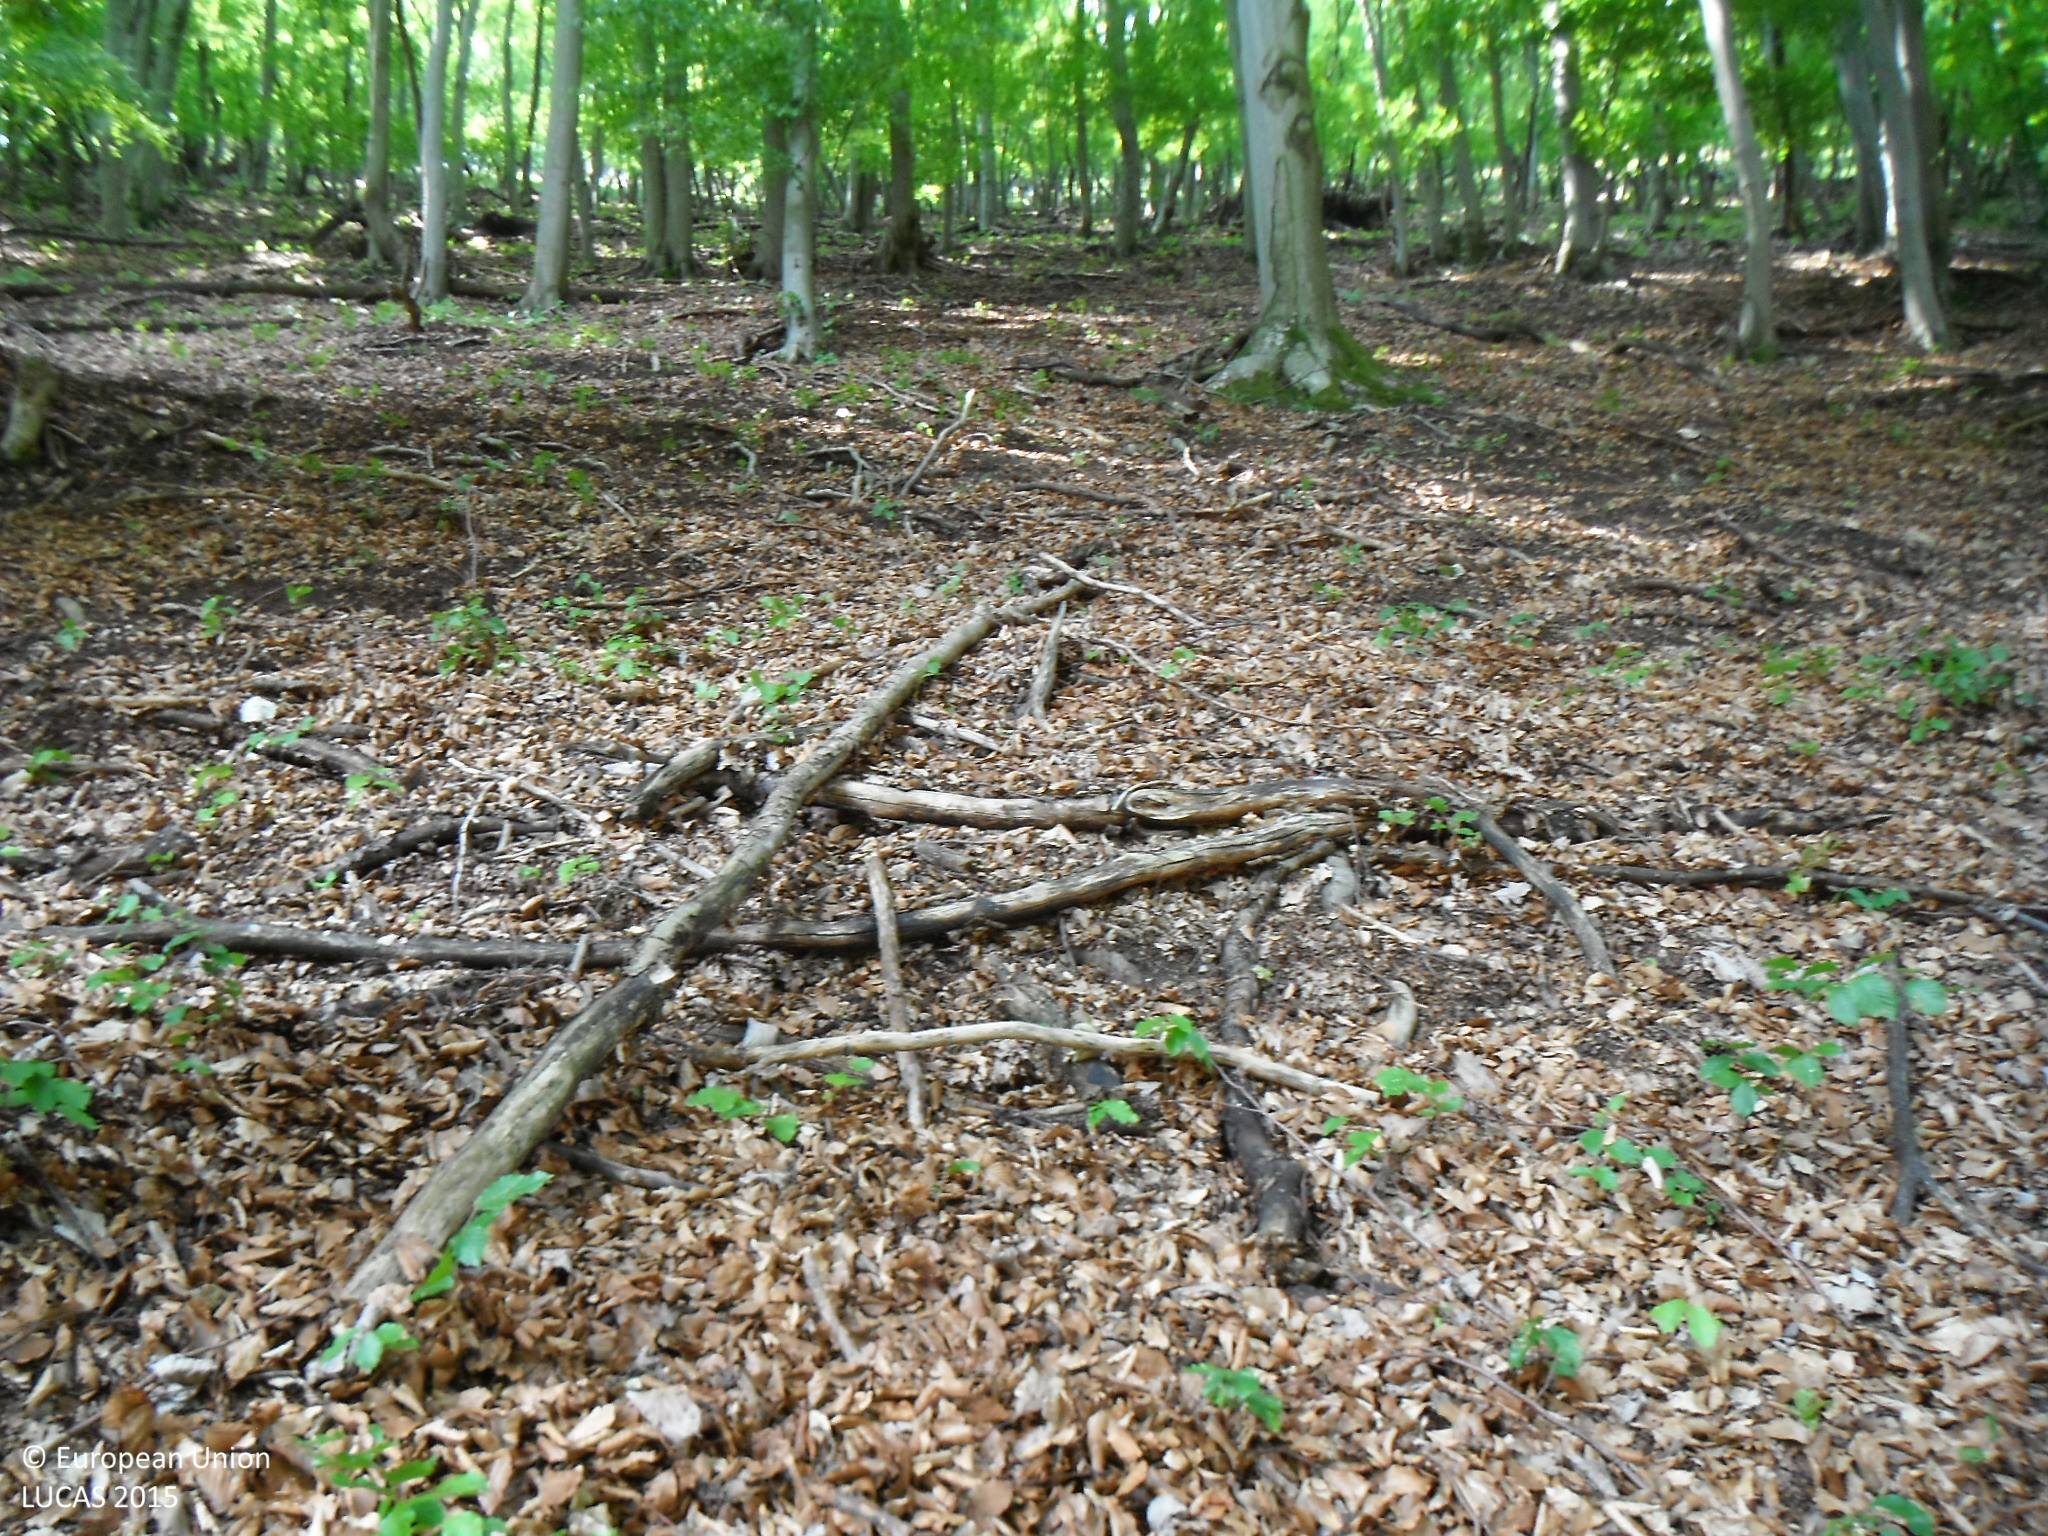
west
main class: Woodland
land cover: Broadleaved woodland
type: mountainous beech forest
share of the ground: > 75 %
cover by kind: broadleaved forest trees 60 %, unconsolidated bare surface 30 %, herbaceous plants 10 %
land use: Forestry
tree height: > 5 m
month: August
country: SK
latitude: 48.9725
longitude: 18.3638
